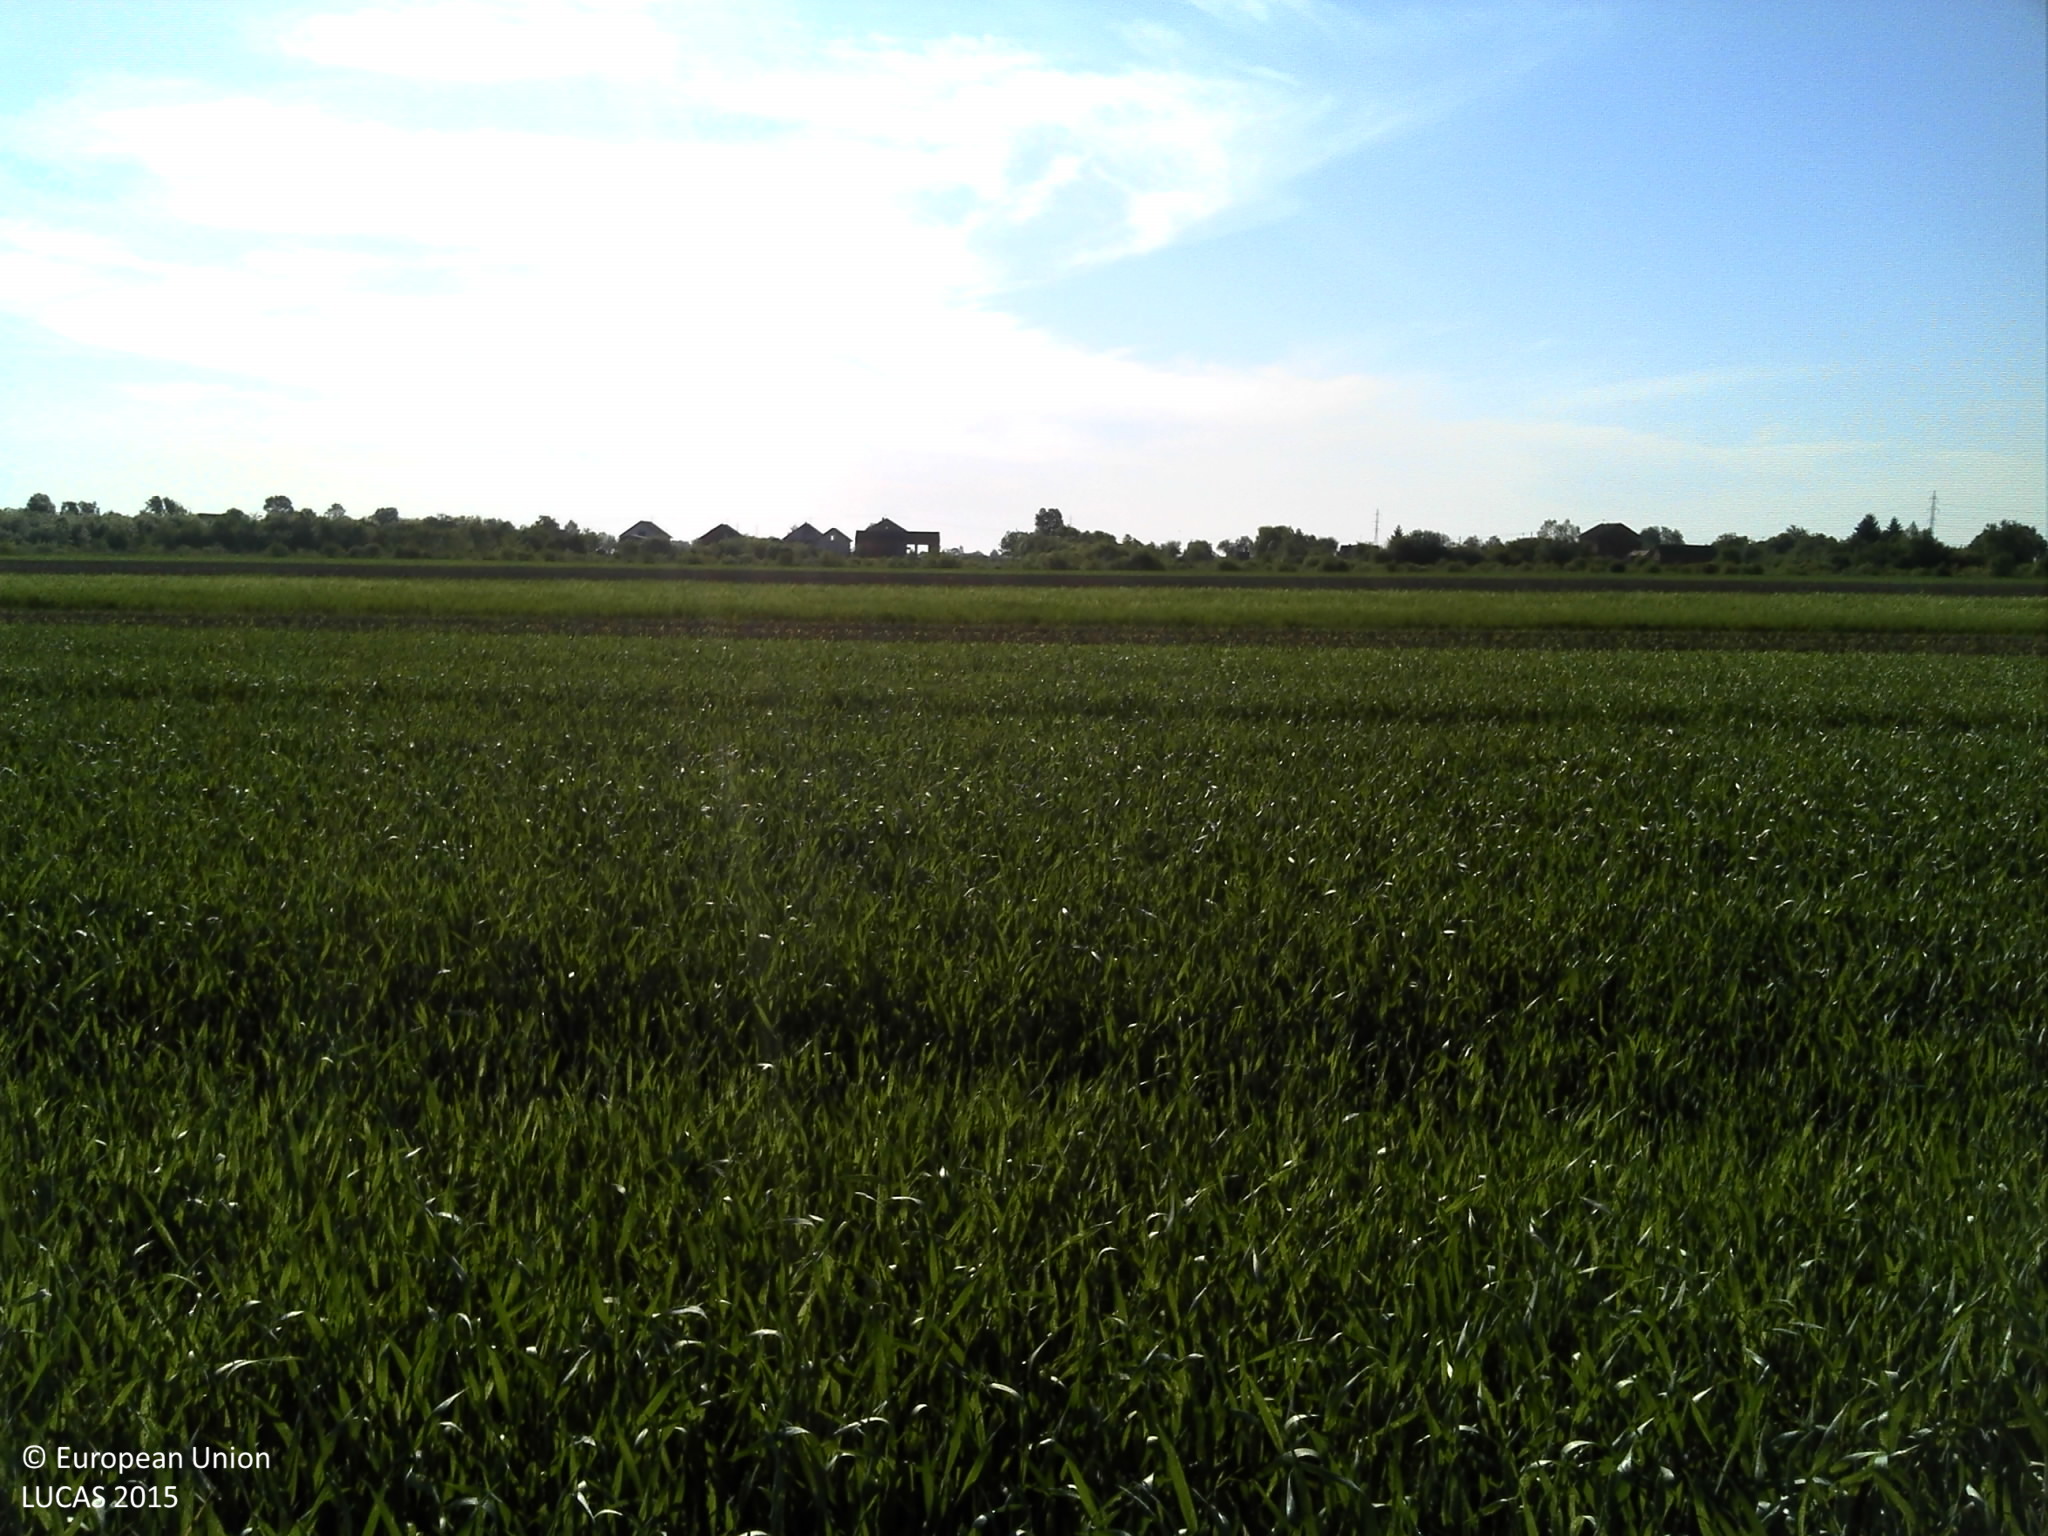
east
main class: Cropland
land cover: Common wheat
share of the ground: > 75 %
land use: Agriculture (excluding fallow land and kitchen gardens)
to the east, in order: Common wheat; Maize; Barley; Maize; Common wheat
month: May
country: HR
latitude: 45.4705
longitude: 18.2551
